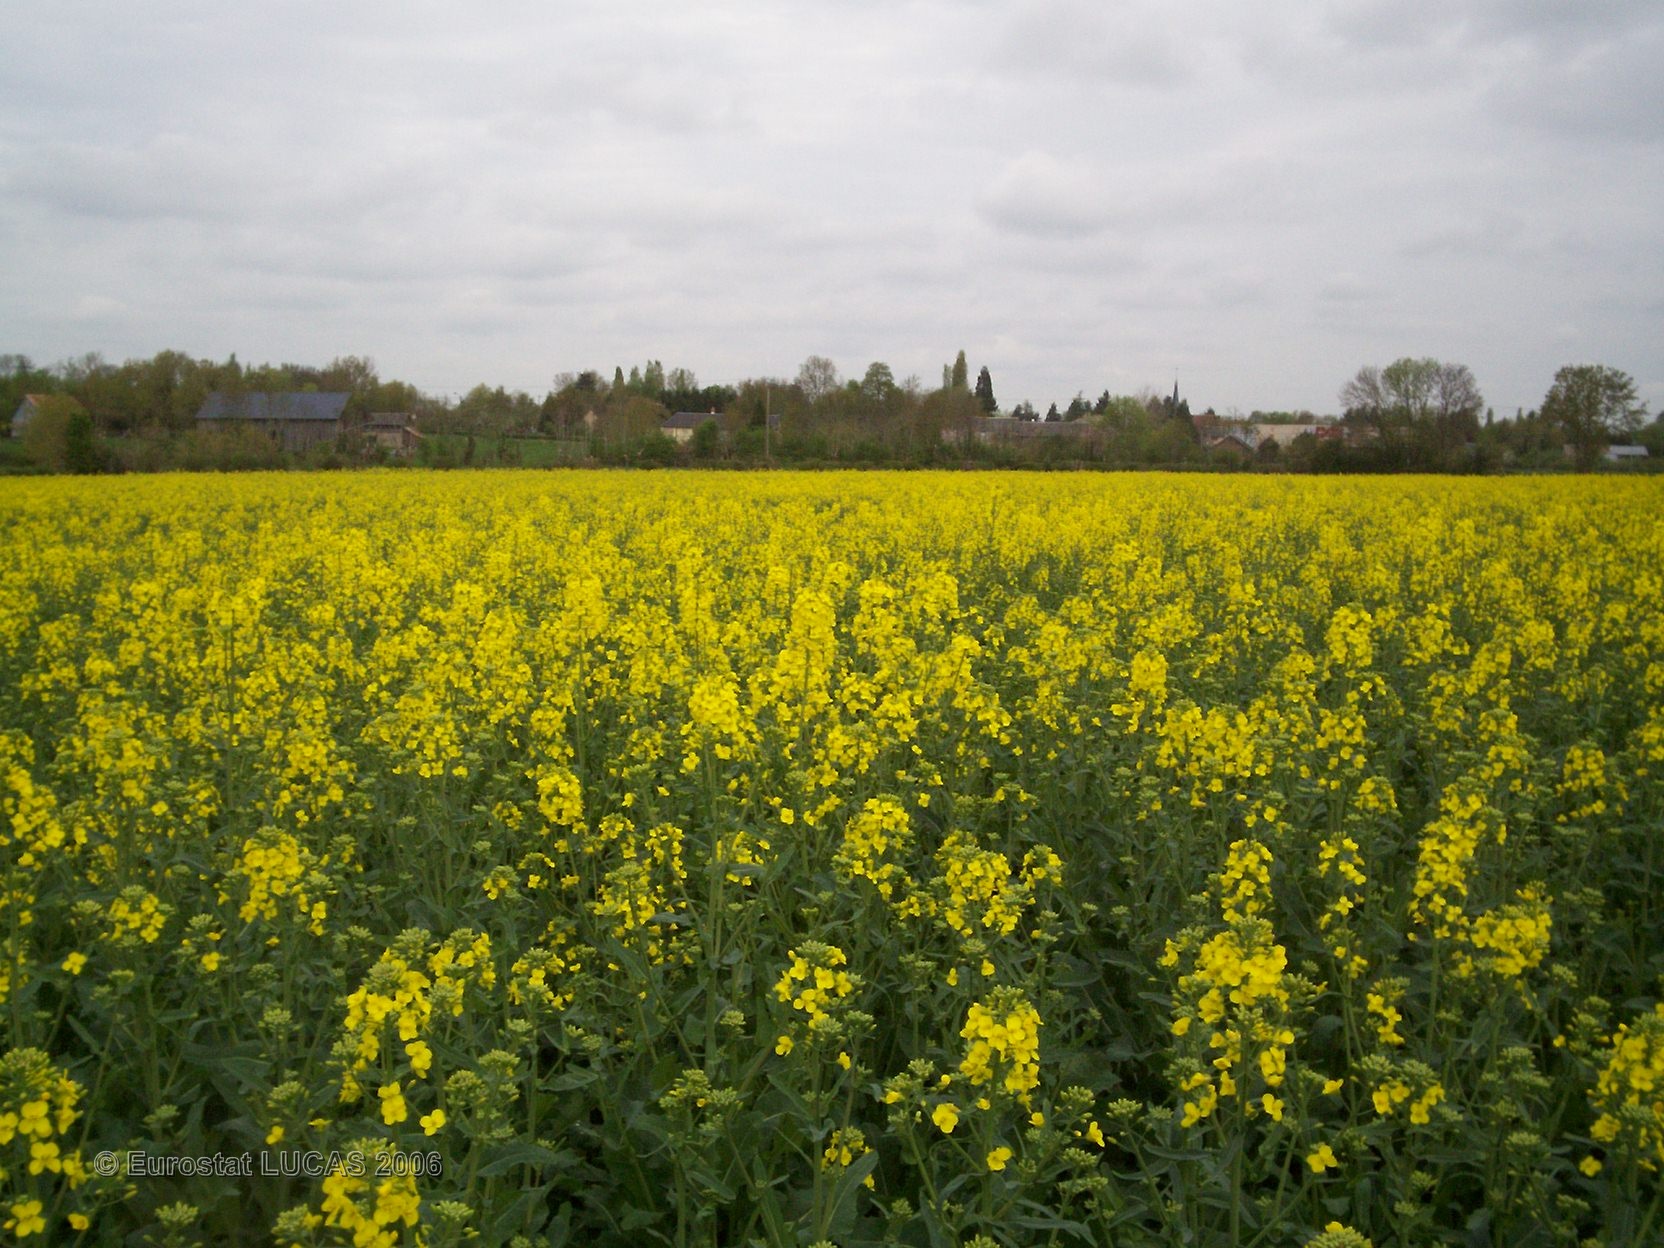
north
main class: Cropland
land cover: Rape and turnip rape
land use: Agriculture (excluding fallow land and kitchen gardens)
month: May
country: FR
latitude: 48.8856
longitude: 0.5512
